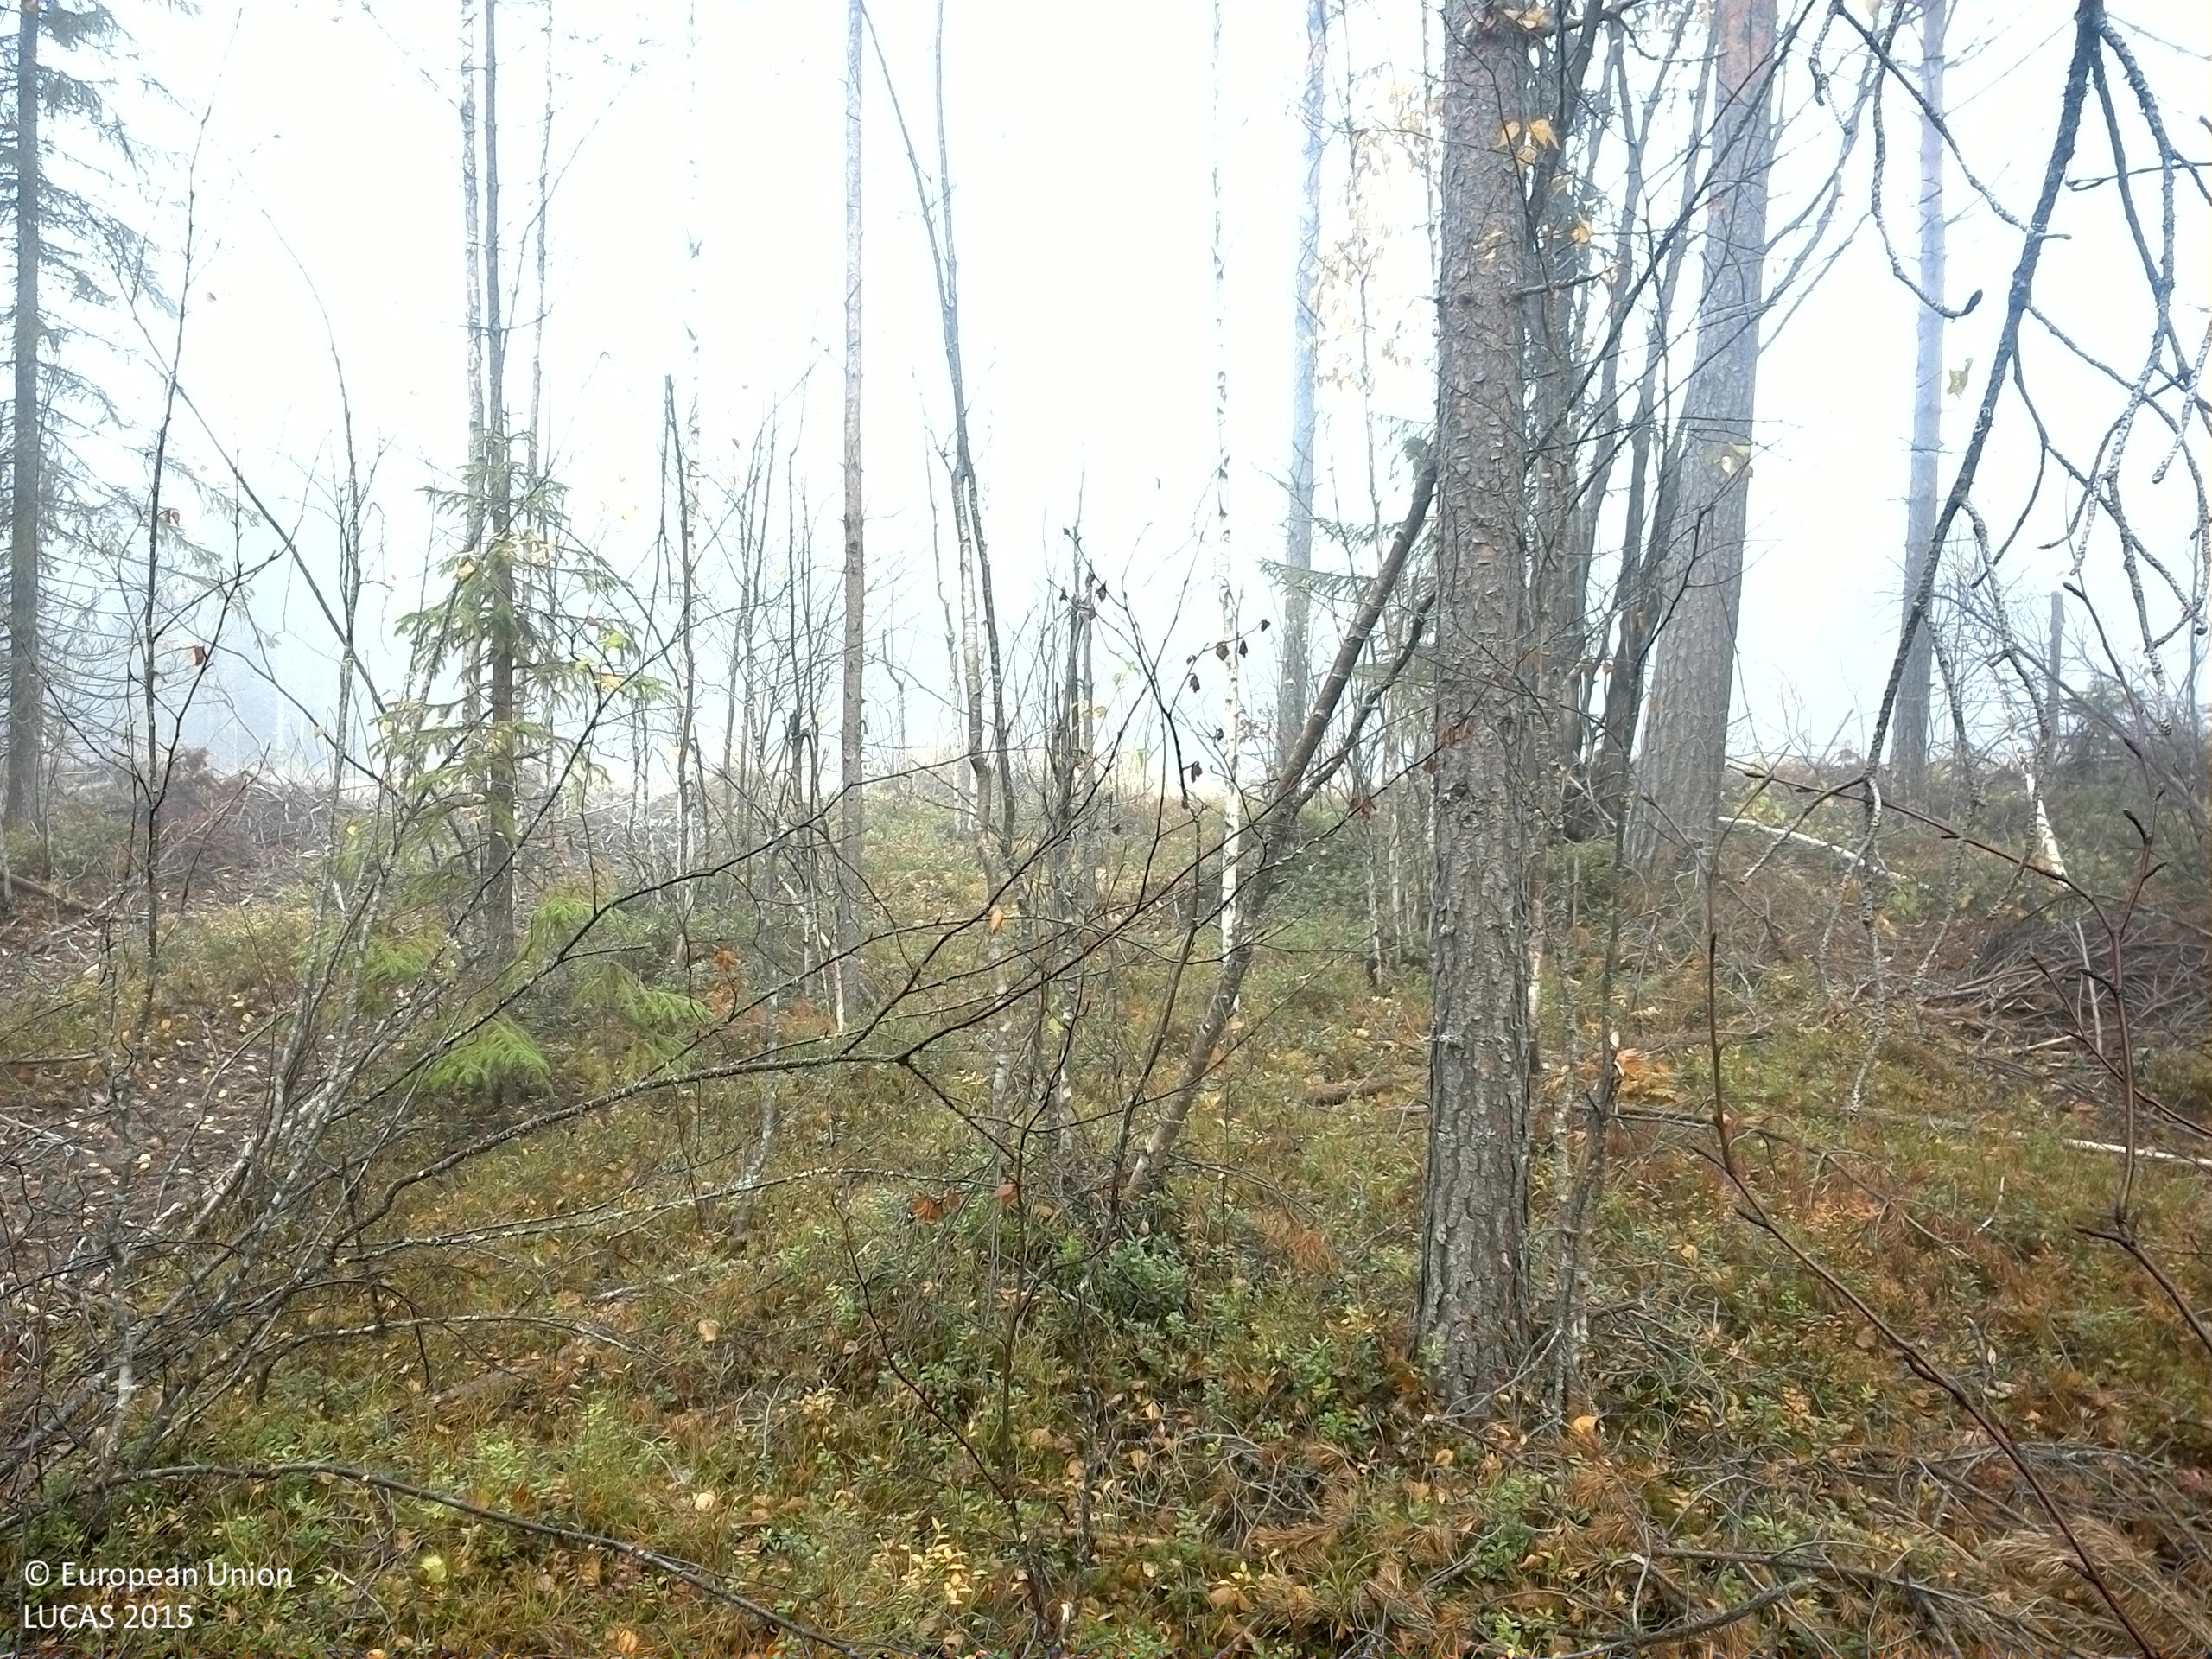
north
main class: Woodland
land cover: Pine dominated mixed woodland
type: boreal forest
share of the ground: 50 - 75 %
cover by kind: coniferous forest trees 45 %, shrubs 30 %, broadleaved forest trees 15 %, lichens and mosses 10 %
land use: Forestry
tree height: > 5 m
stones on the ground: 10 - 25 %
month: October
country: SE
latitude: 64.0017
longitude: 16.2893
